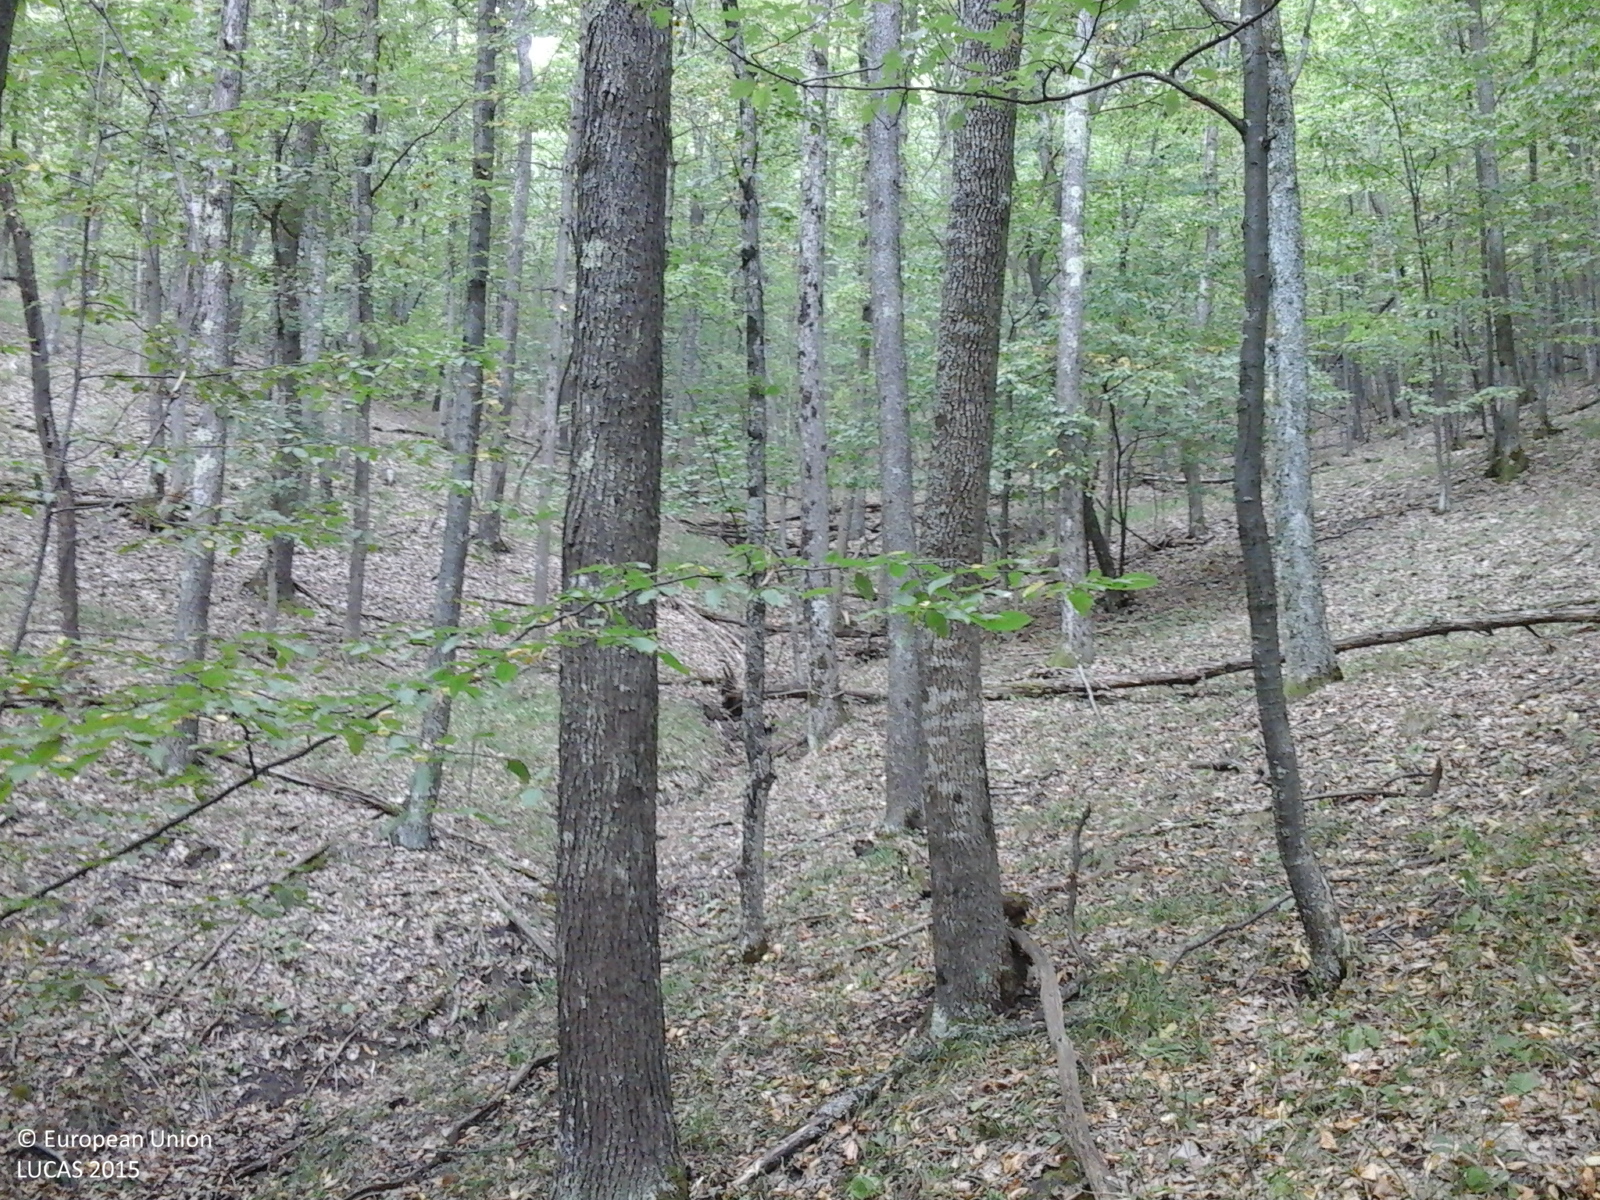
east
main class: Woodland
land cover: Broadleaved woodland
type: mesophytic deciduous forest
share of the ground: > 75 %
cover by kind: broadleaved forest trees 100 %
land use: Forestry
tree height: > 5 m
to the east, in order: Broadleaved woodland; Tracks; Broadleaved woodland
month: August
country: RO
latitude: 44.7165
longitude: 23.8332
